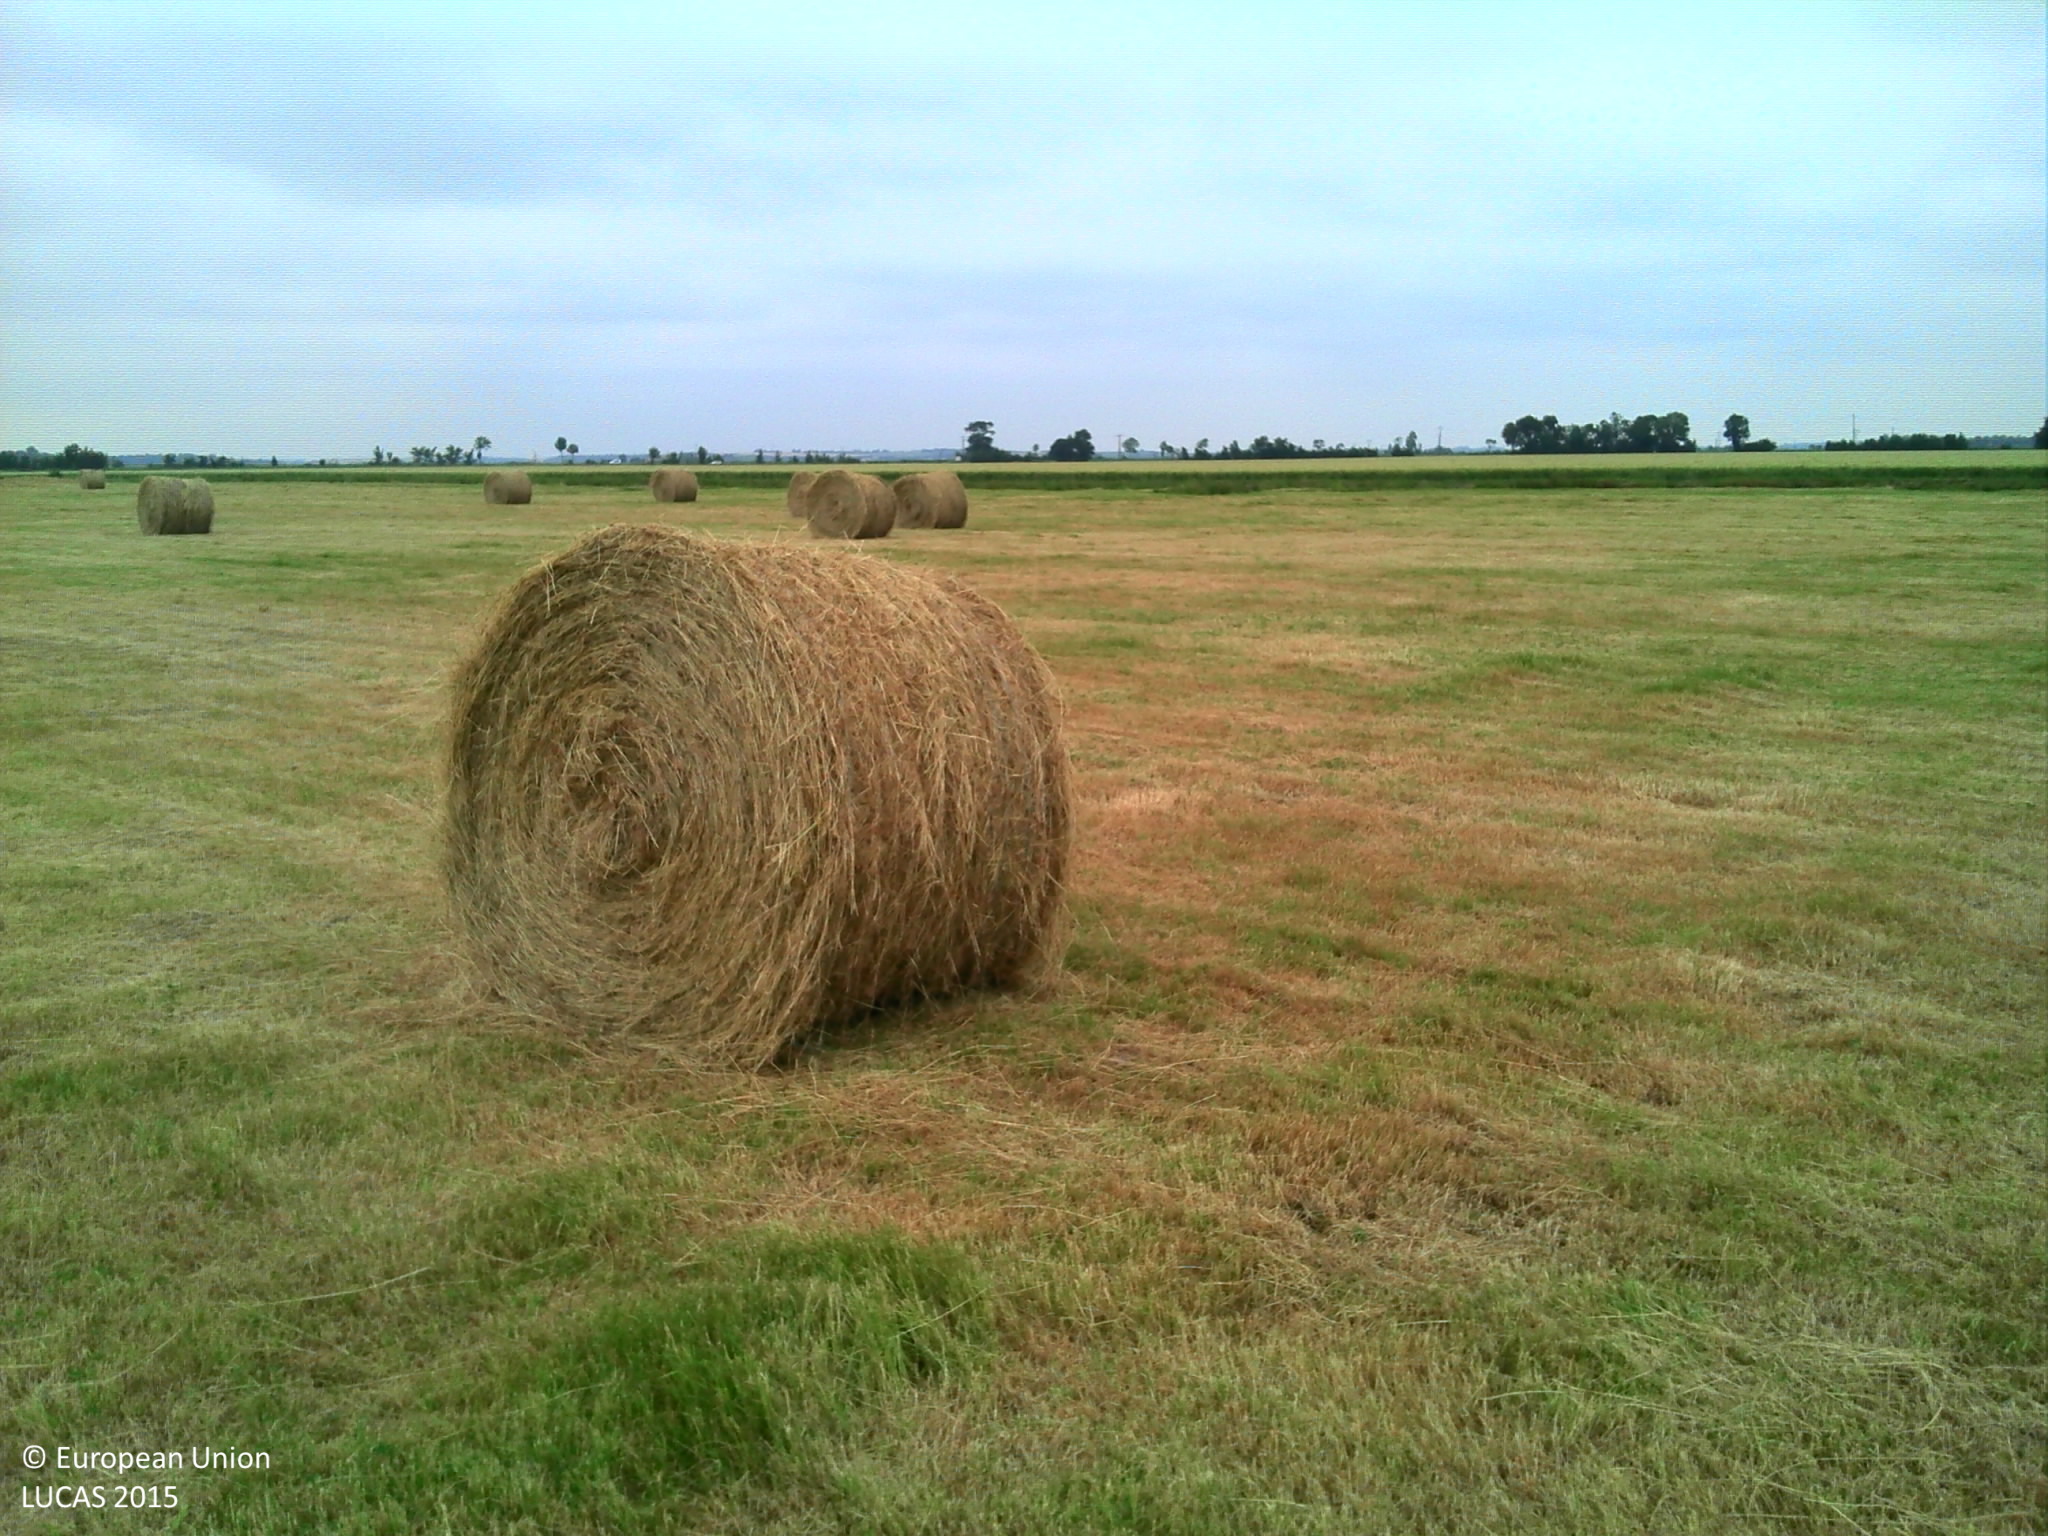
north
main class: Grassland
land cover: Grassland without tree/shrub cover
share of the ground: > 75 %
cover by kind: herbaceous plants 100 %
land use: Agriculture (excluding fallow land and kitchen gardens)
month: June
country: FR
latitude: 45.9733
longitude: -0.9081
